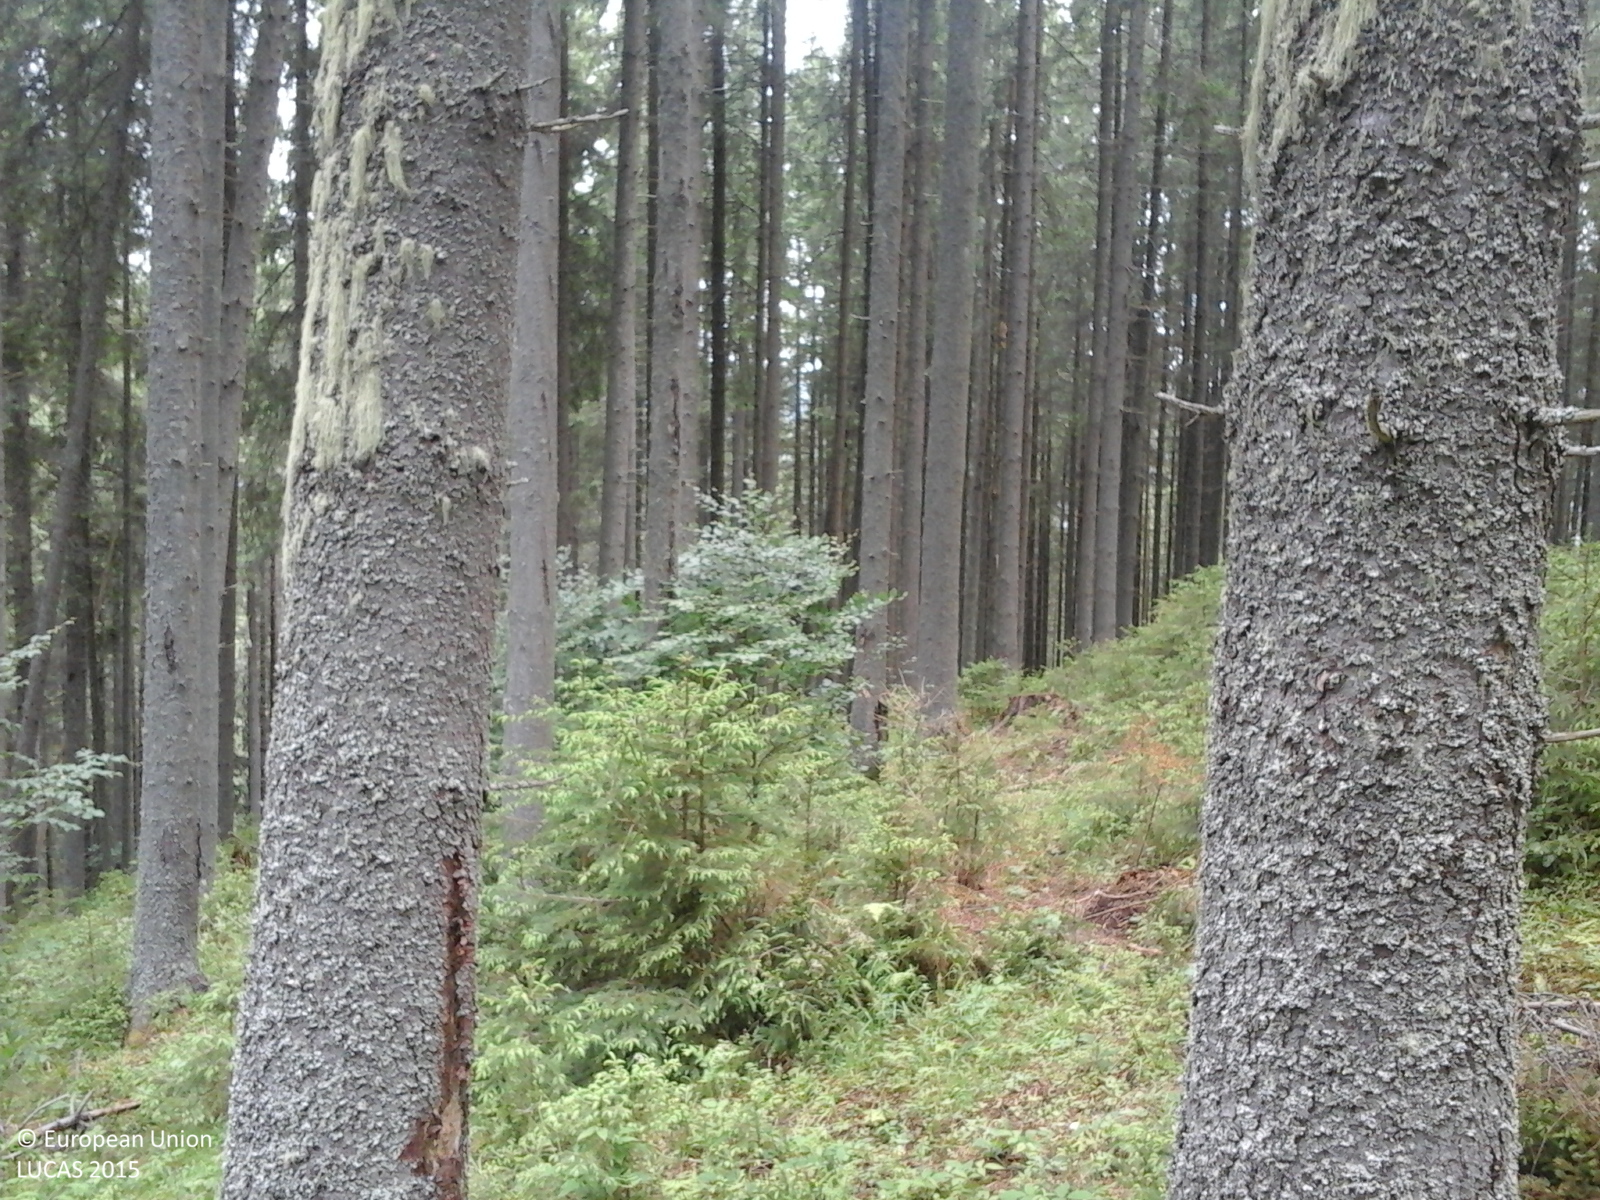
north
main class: Woodland
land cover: Spruce dominated coniferous woodland
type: alpine coniferous forest
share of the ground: > 75 %
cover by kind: coniferous forest trees 100 %
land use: Forestry
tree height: > 5 m
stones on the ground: < 10 %
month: June
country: RO
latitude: 47.4069
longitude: 25.1480
